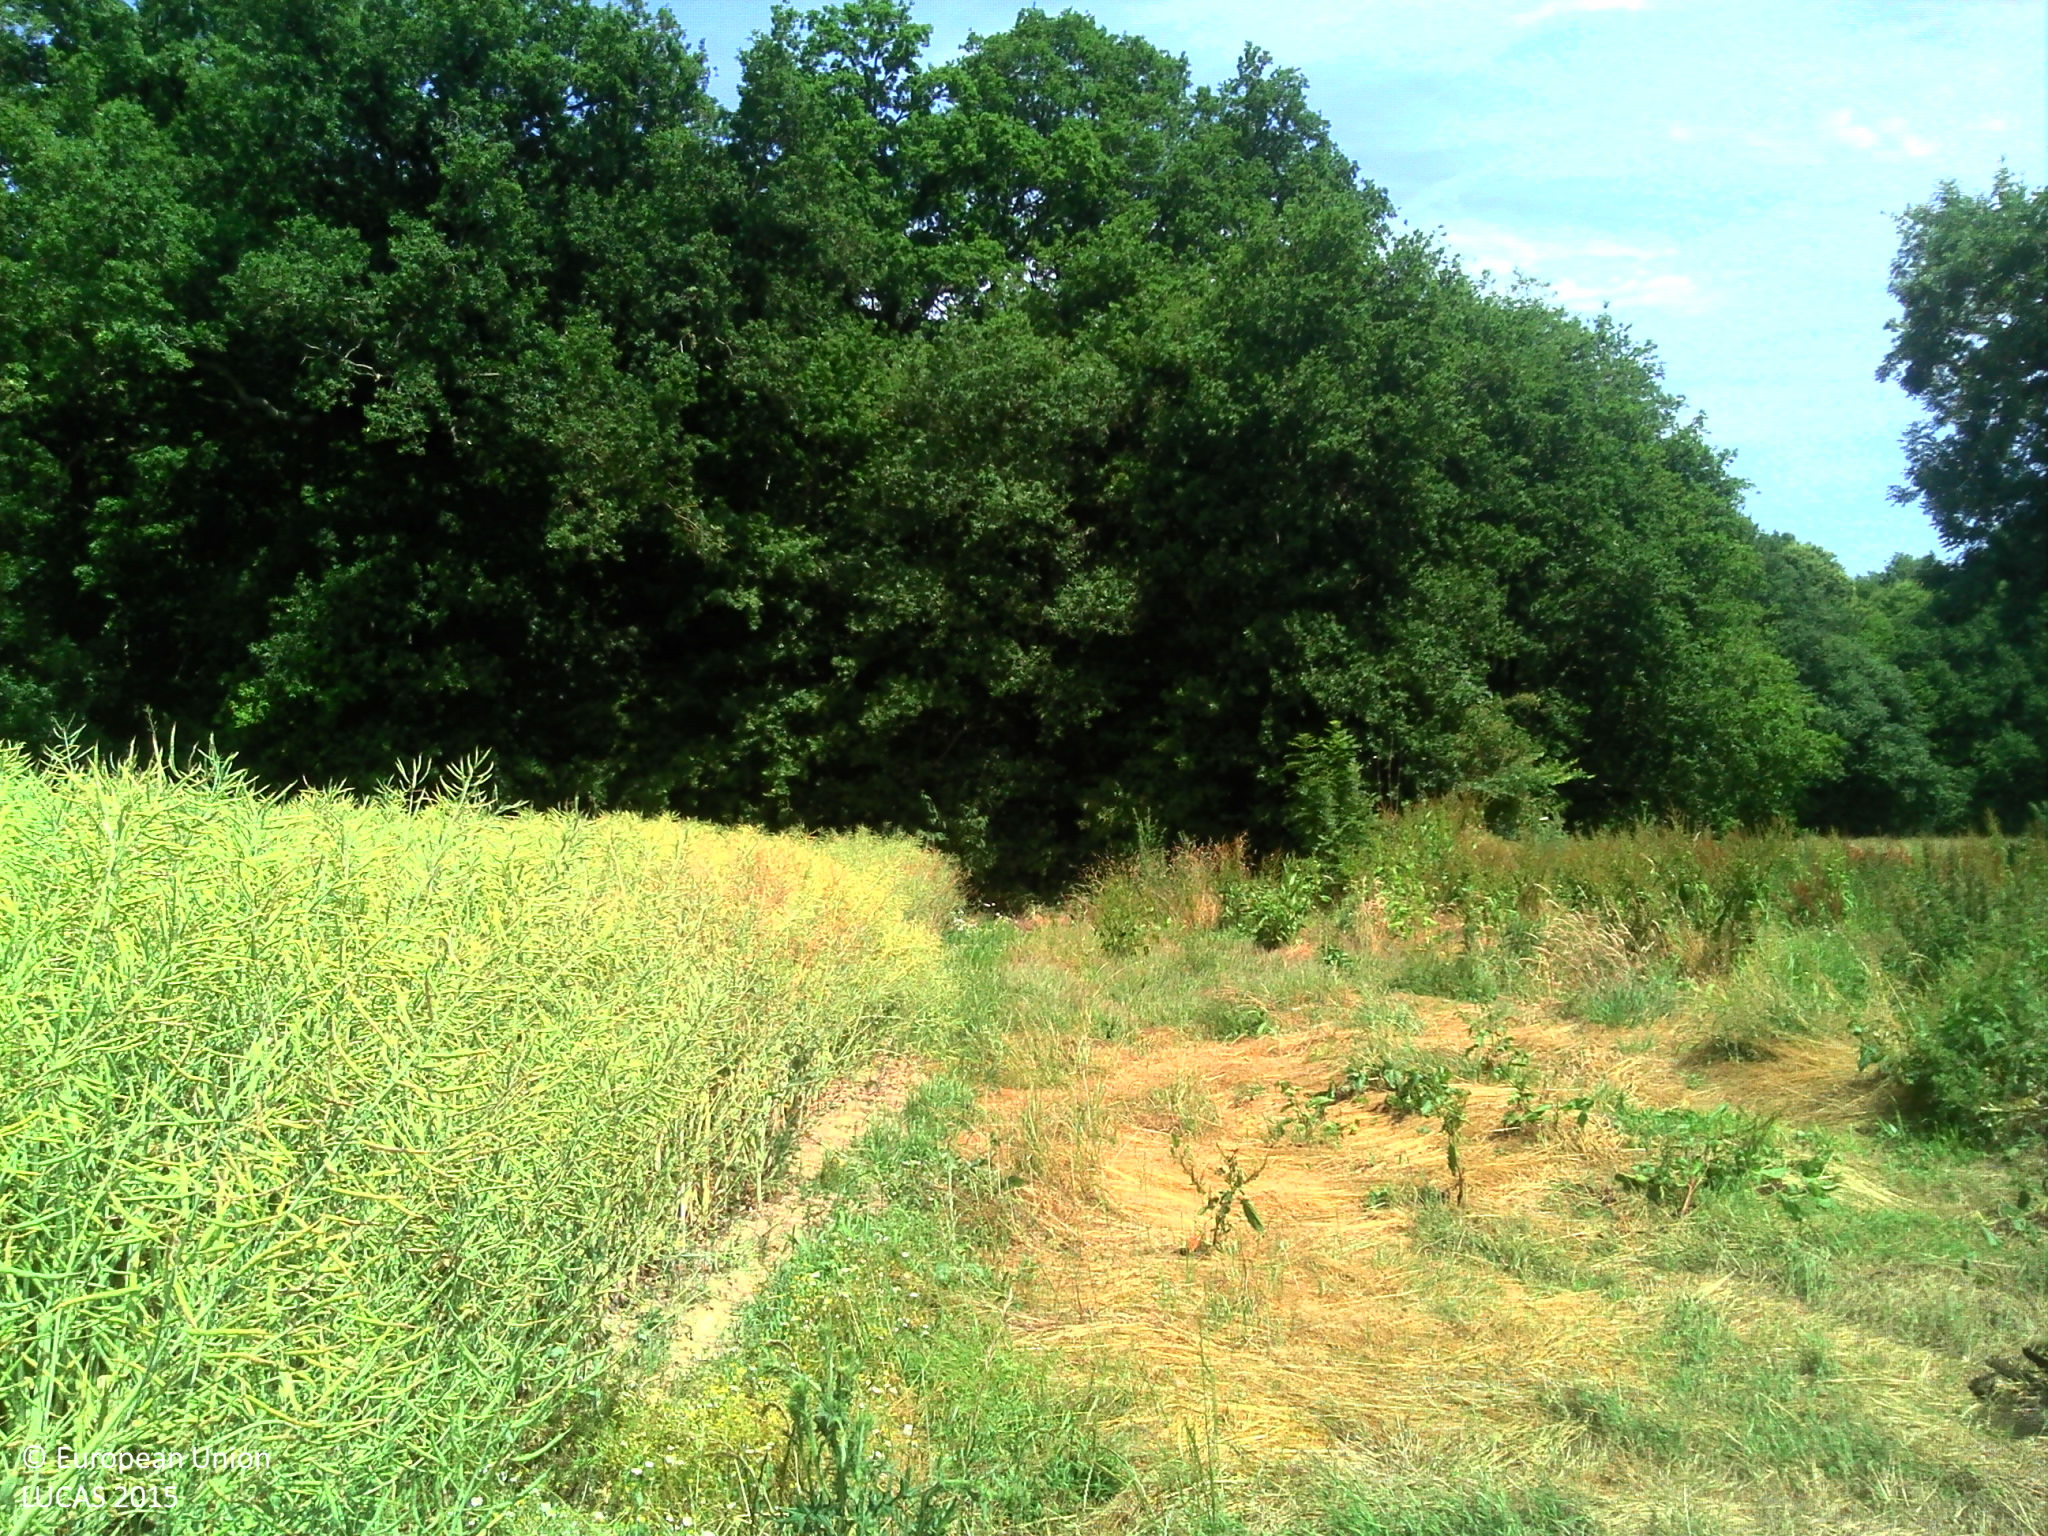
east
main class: Cropland
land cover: Rape and turnip rape
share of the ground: > 75 %
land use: Agriculture (excluding fallow land and kitchen gardens)
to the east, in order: Rape and turnip rape; Spontaneously vegetated surfaces; Broadleaved woodland; Tracks; Spontaneously vegetated surfaces; Broadleaved woodland
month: June
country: FR
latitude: 49.0682
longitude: 1.2338
